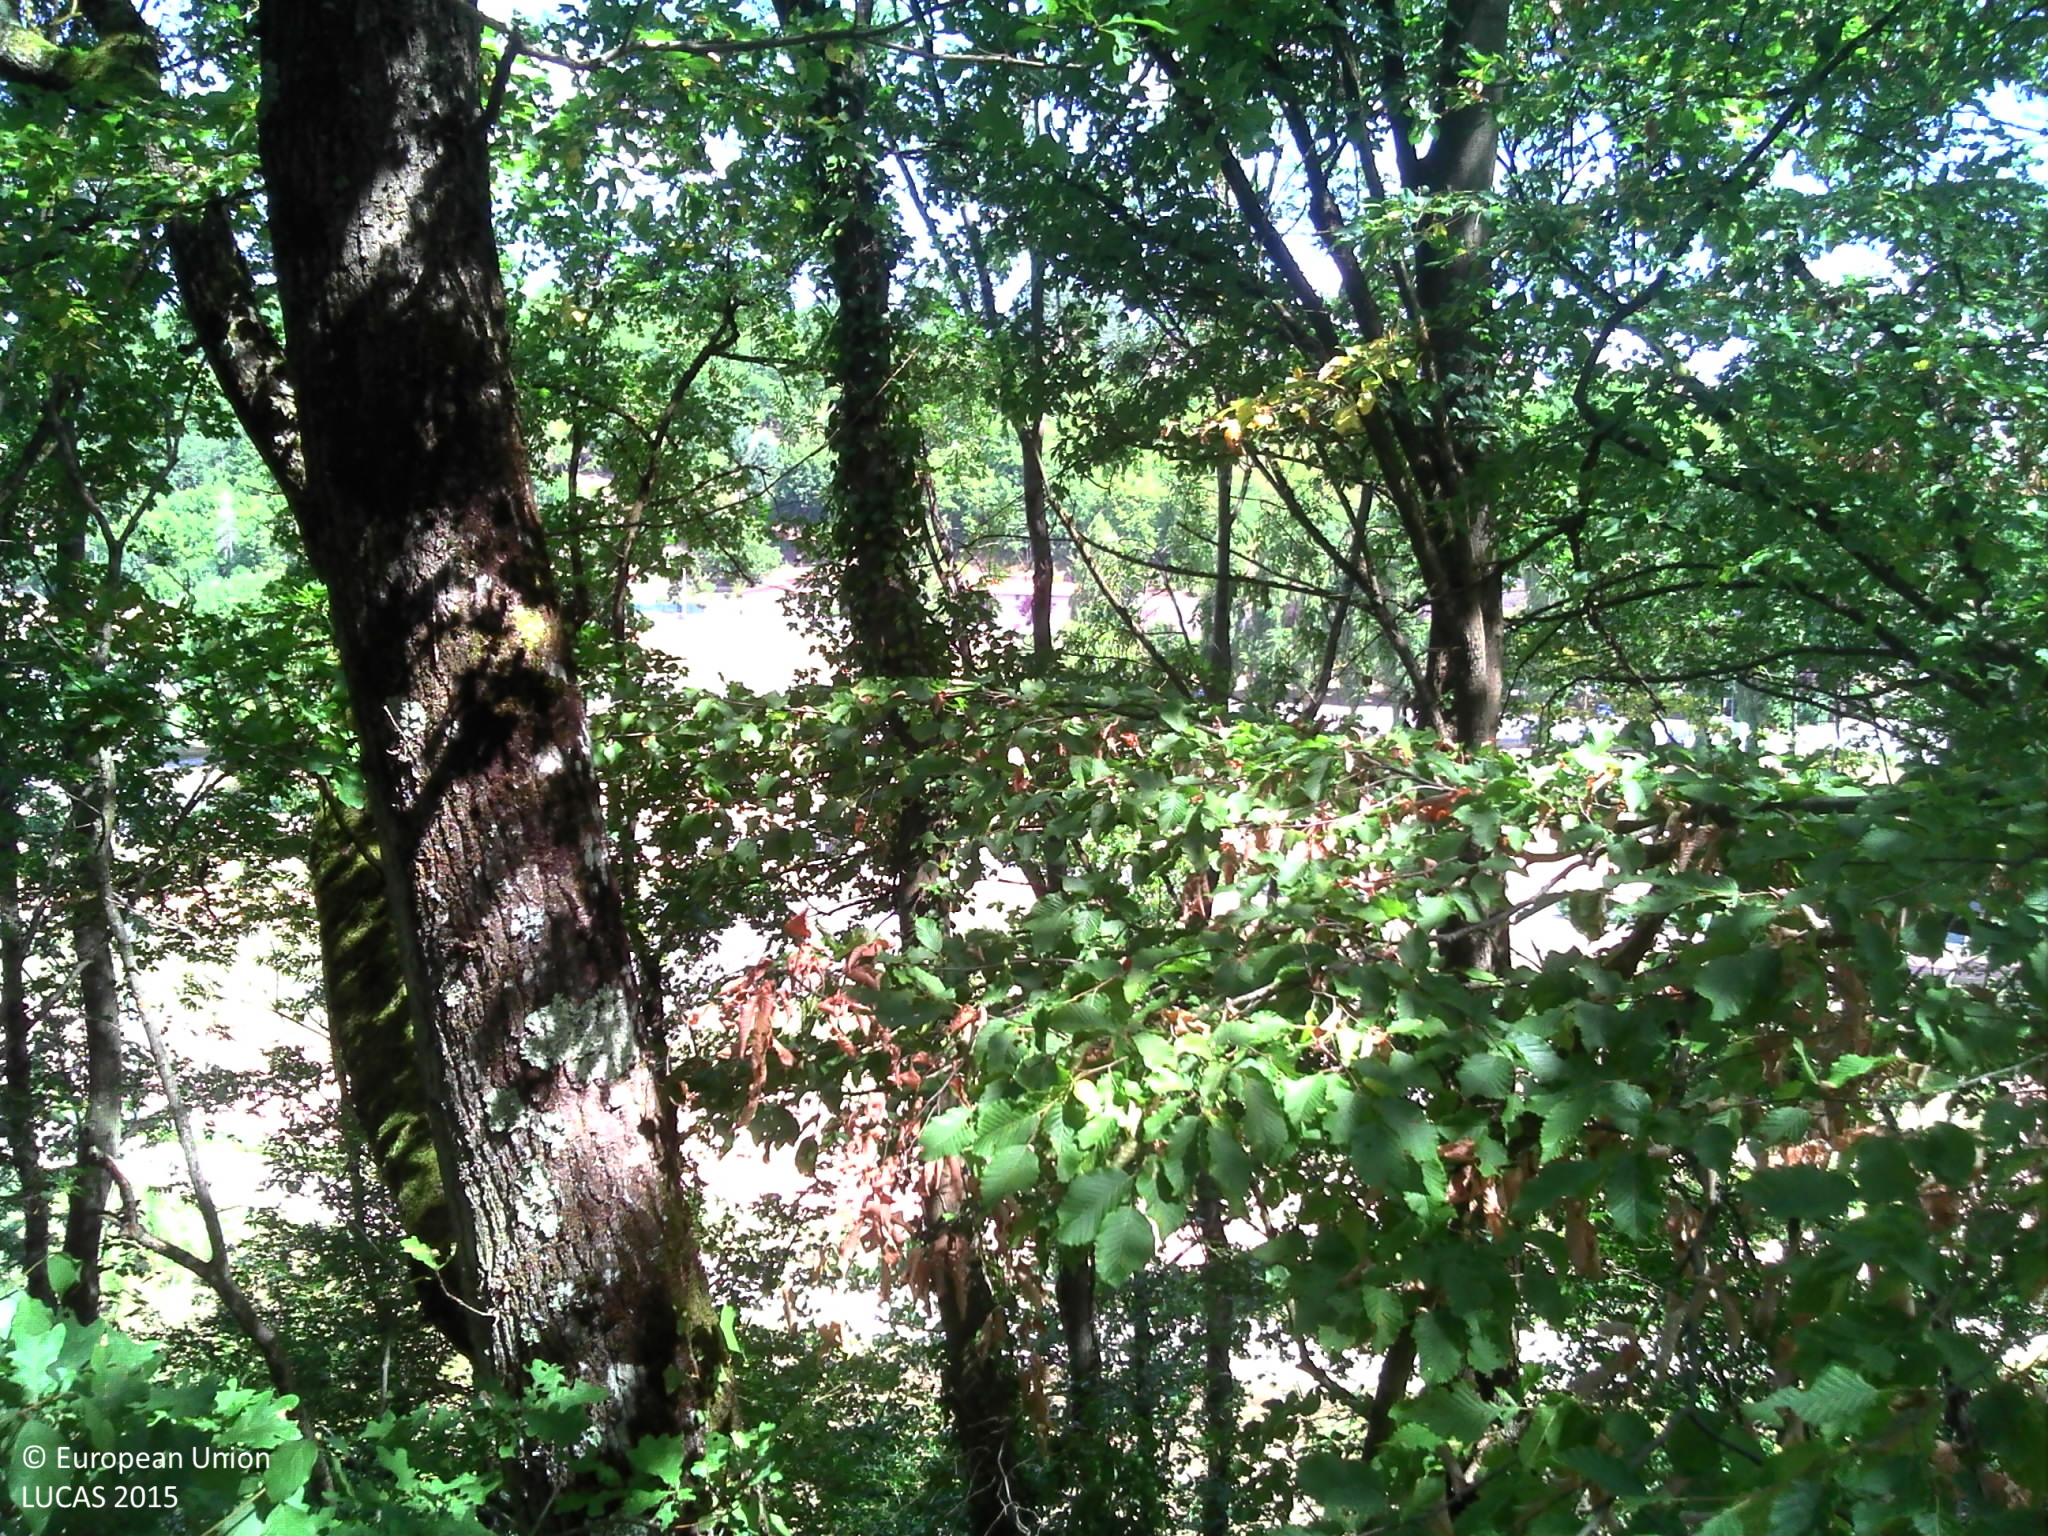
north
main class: Woodland
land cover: Broadleaved woodland
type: mesophytic deciduous forest
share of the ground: > 75 %
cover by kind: broadleaved forest trees 100 %
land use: Community services
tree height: > 5 m
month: July
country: FR
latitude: 45.8362
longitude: 4.6087
